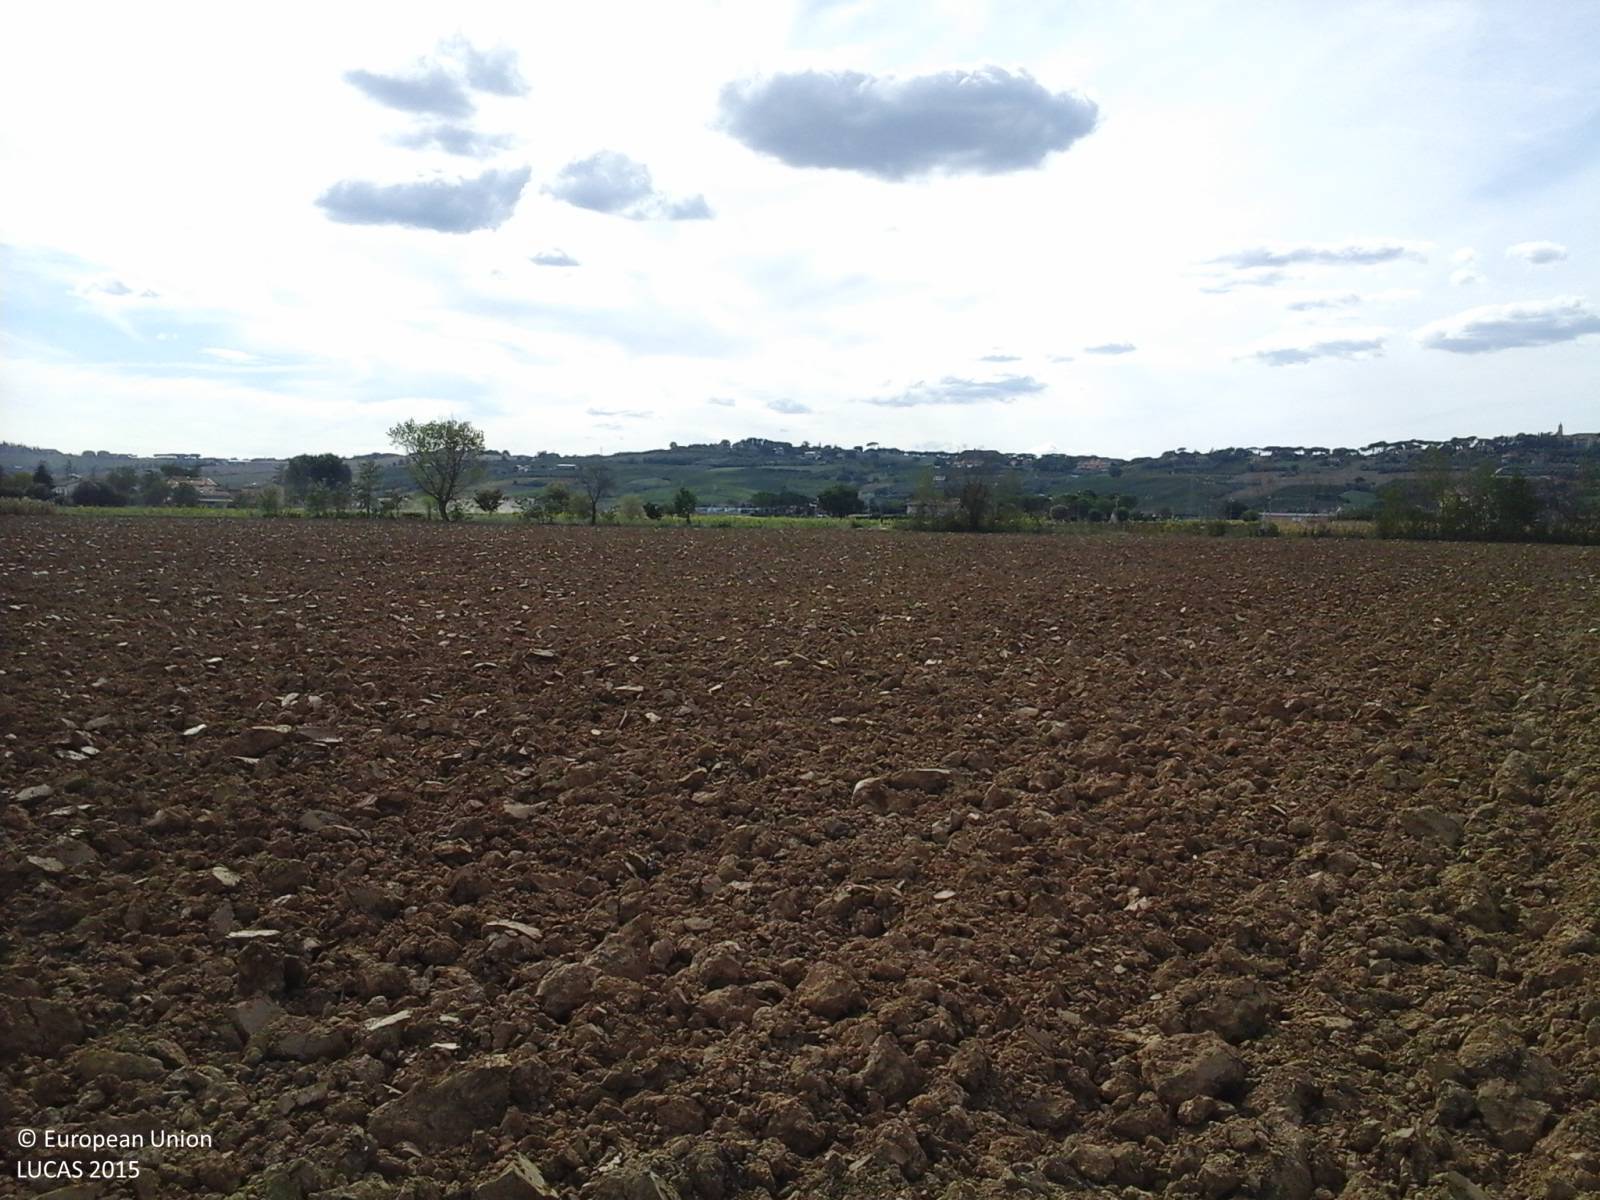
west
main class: Cropland
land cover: Maize
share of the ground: > 75 %
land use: Agriculture (excluding fallow land and kitchen gardens)
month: September
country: IT
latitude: 43.0053
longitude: 12.3851
